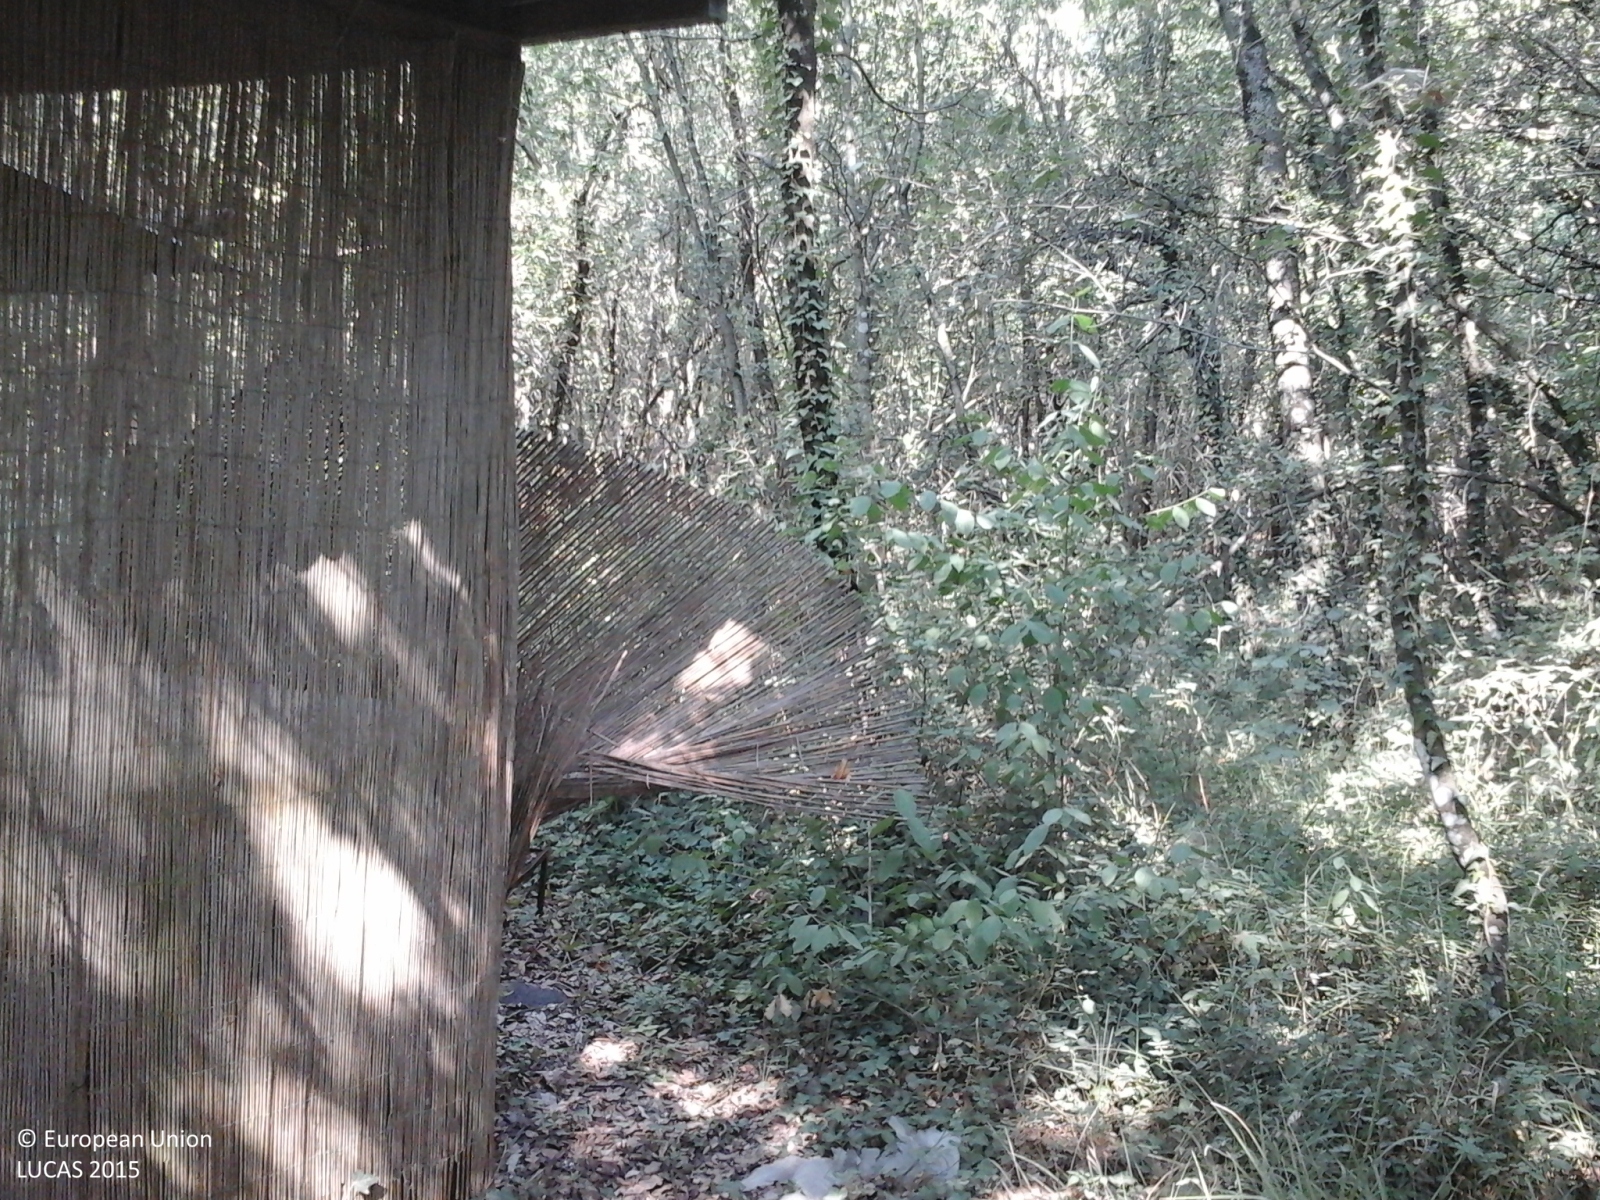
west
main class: Woodland
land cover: Broadleaved woodland
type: mesophytic deciduous forest
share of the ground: > 75 %
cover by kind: broadleaved forest trees 100 %
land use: Forestry
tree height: > 5 m
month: July
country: IT
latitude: 43.2984
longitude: 11.0693
